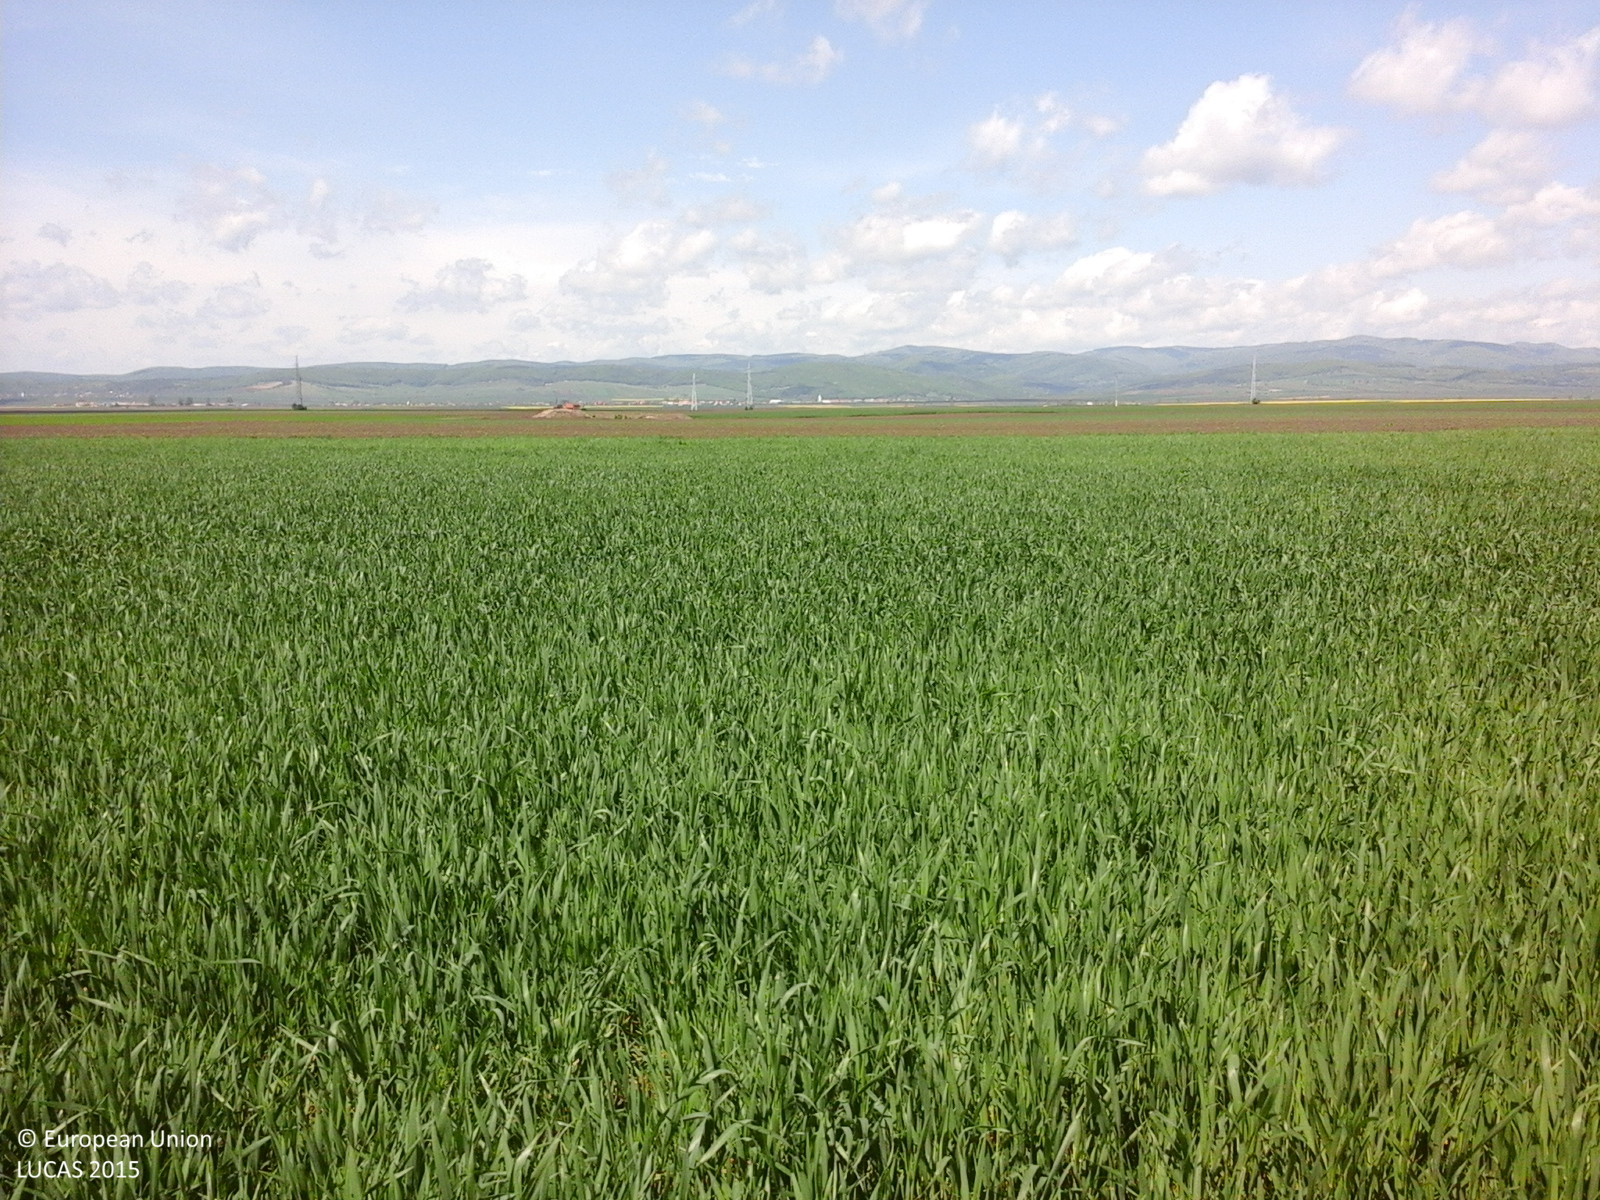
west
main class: Cropland
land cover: Common wheat
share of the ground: > 75 %
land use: Agriculture (excluding fallow land and kitchen gardens)
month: May
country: RO
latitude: 45.9469
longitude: 26.1024
